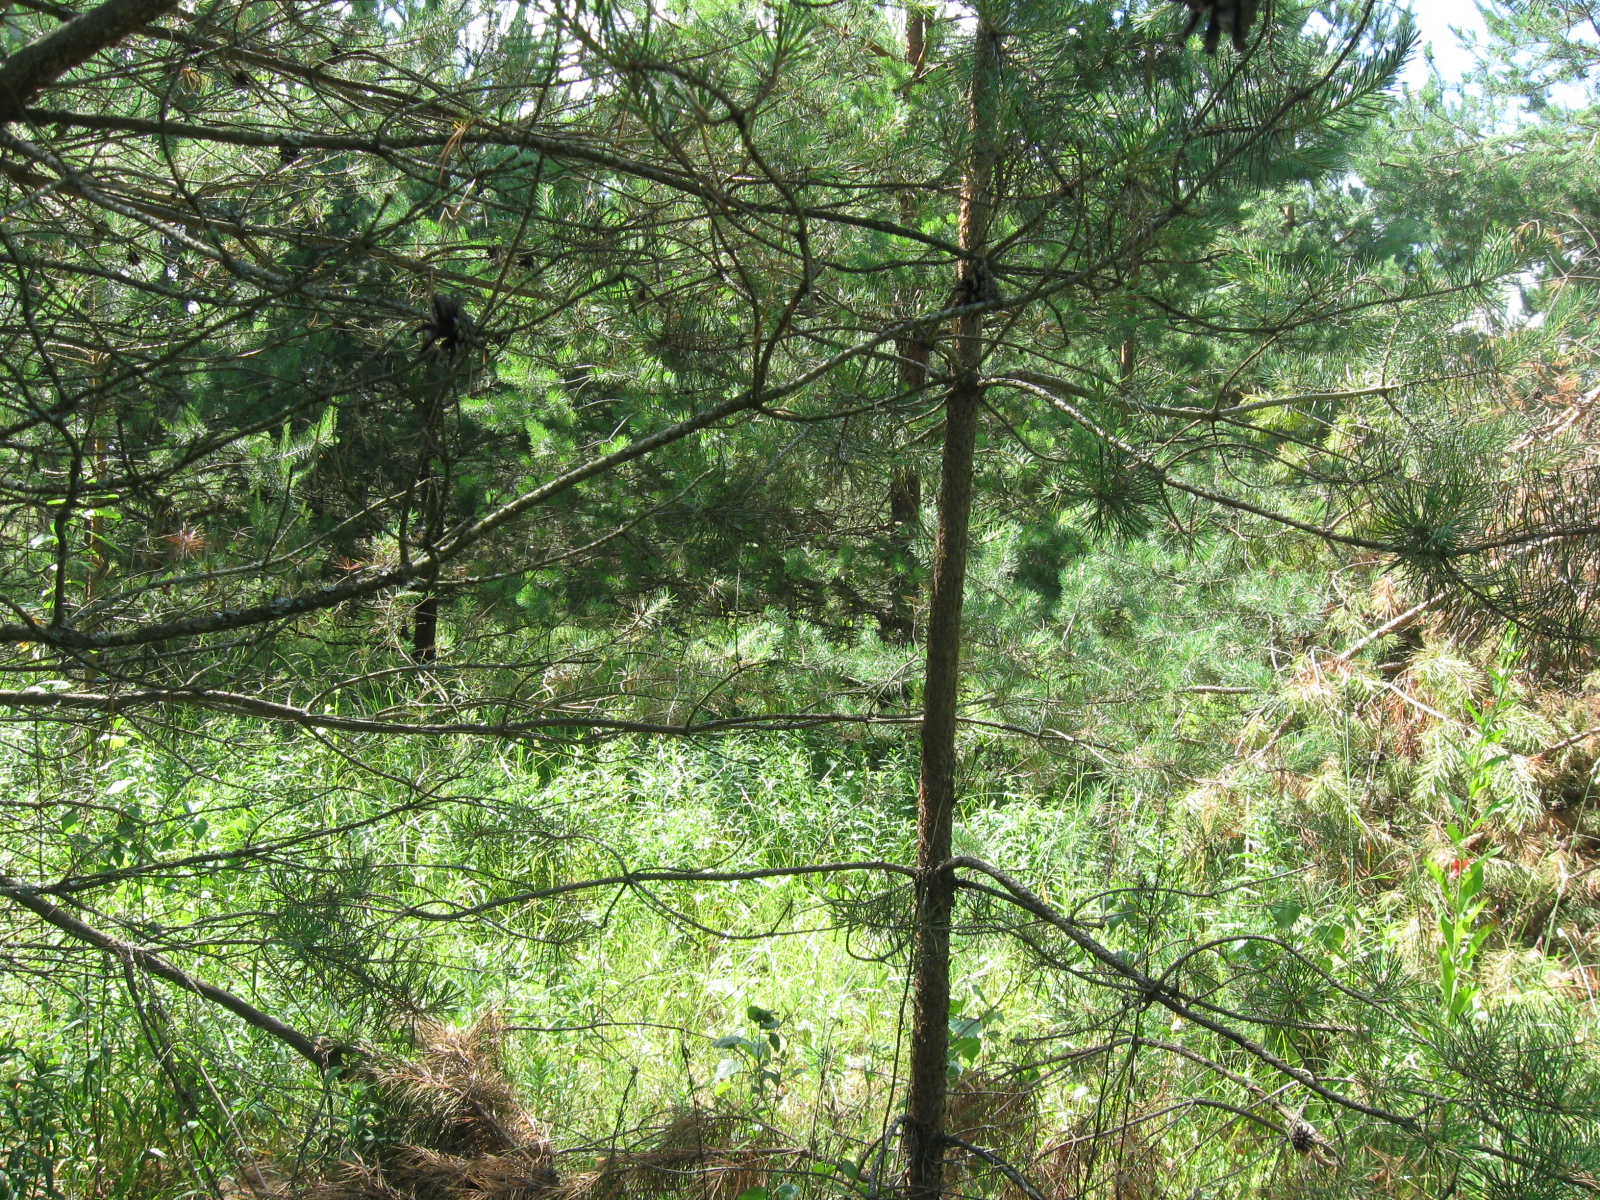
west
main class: Woodland
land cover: Pine dominated mixed woodland
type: hemiboreal forest and nemoral coniferous forest and mixed broadleaved-coniferous forest
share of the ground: > 75 %
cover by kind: coniferous forest trees 50 %, broadleaved forest trees 30 %, herbaceous plants 20 %
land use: Forestry
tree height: > 5 m
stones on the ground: < 10 %
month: July
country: LT
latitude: 54.2126
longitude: 24.2827
